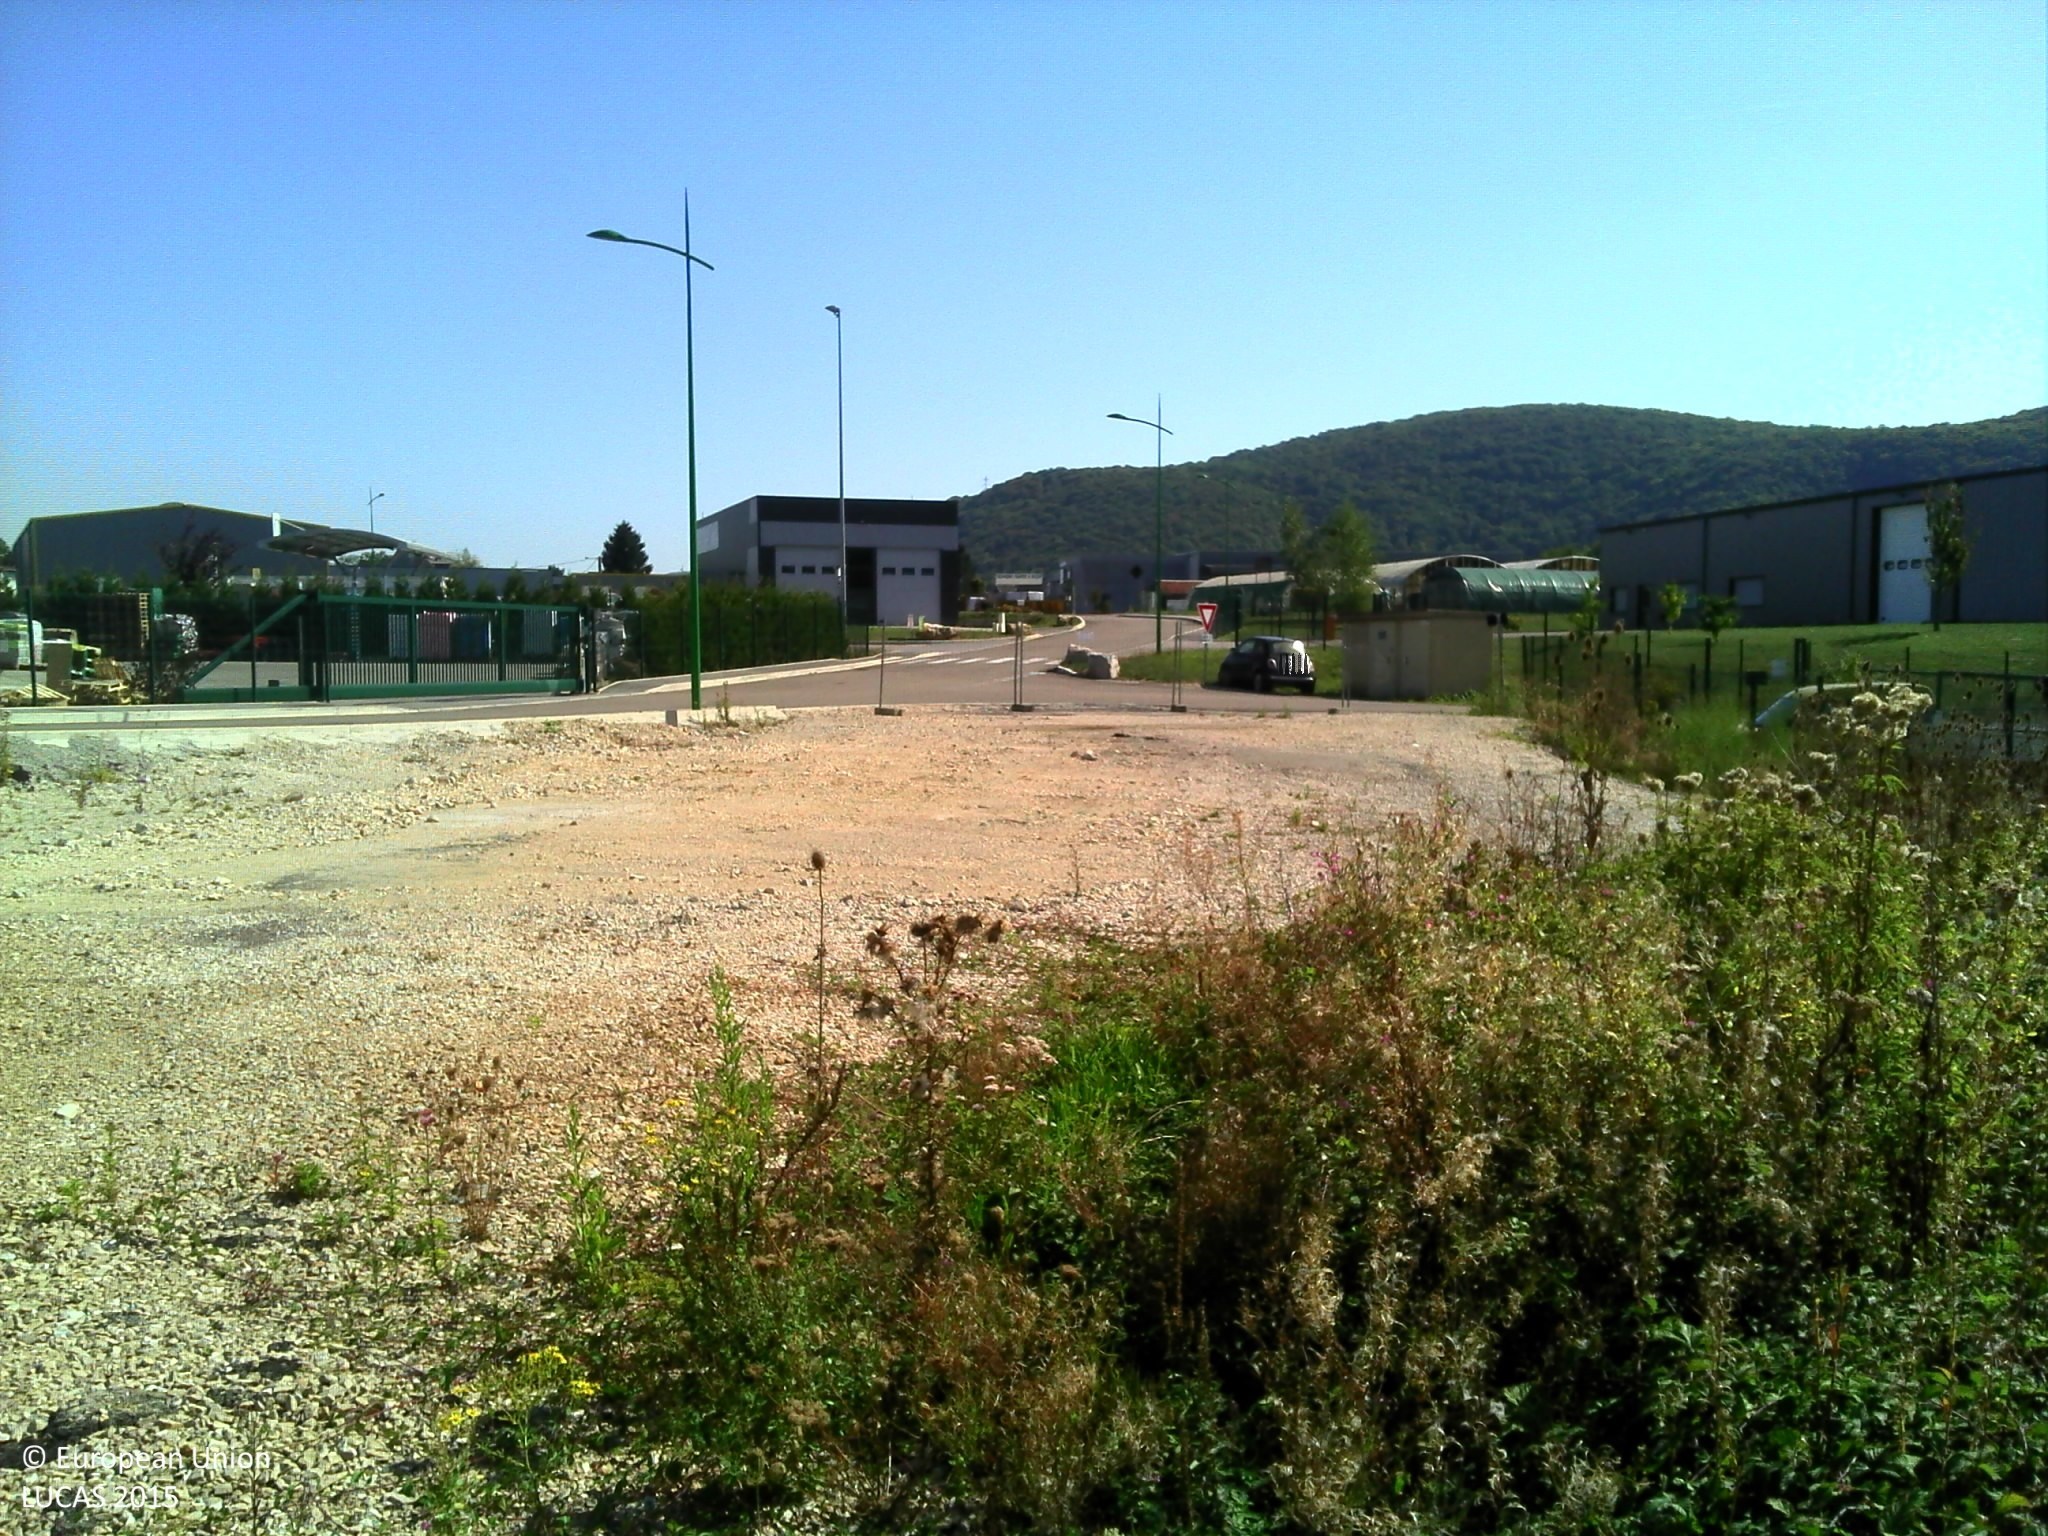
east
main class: Grassland
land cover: Spontaneously vegetated surfaces
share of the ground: > 75 %
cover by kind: herbaceous plants 95 %, shrubs 5 %
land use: Commerce
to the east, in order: Spontaneously vegetated surfaces; Artificial constructions in urban areas; Grassland without tree/shrub cover; Managed hedges
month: September
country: FR
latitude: 47.2717
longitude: 6.1024
